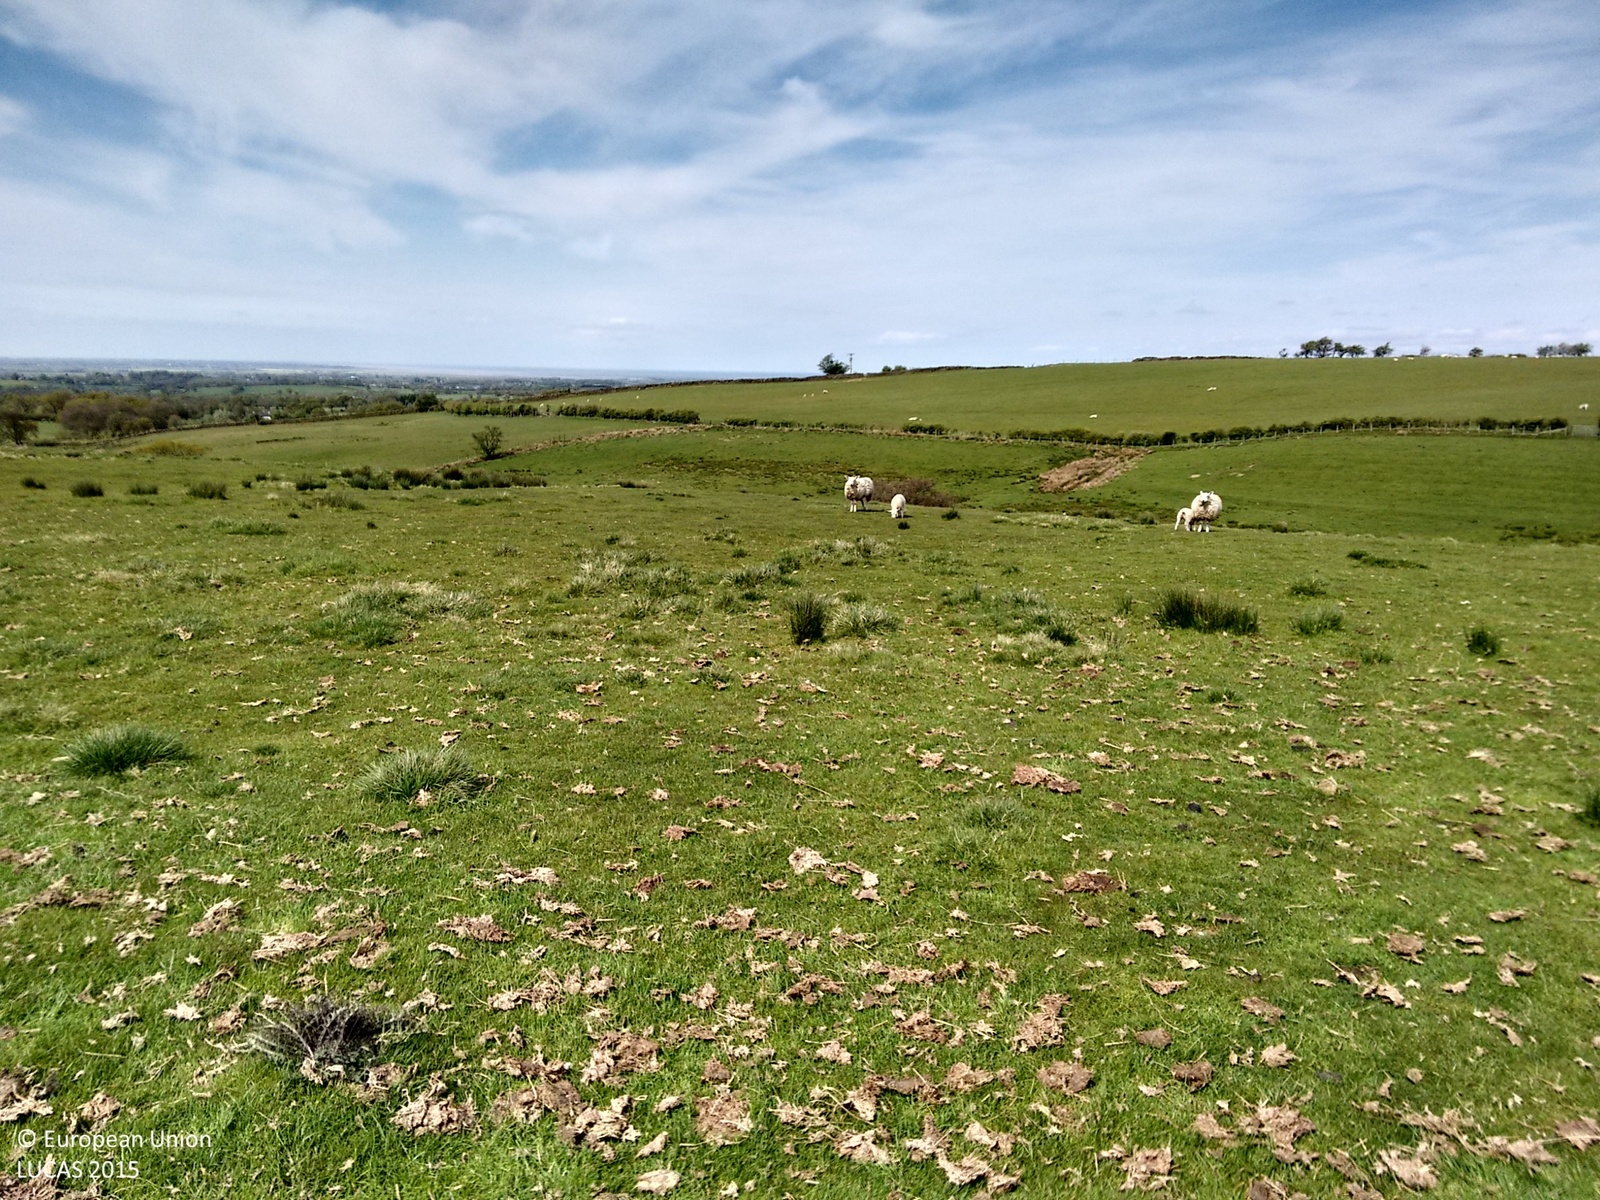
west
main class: Grassland
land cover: Grassland without tree/shrub cover
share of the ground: > 75 %
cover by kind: herbaceous plants 100 %
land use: Agriculture (excluding fallow land and kitchen gardens)
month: May
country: GB
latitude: 53.9677
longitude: -2.7054
